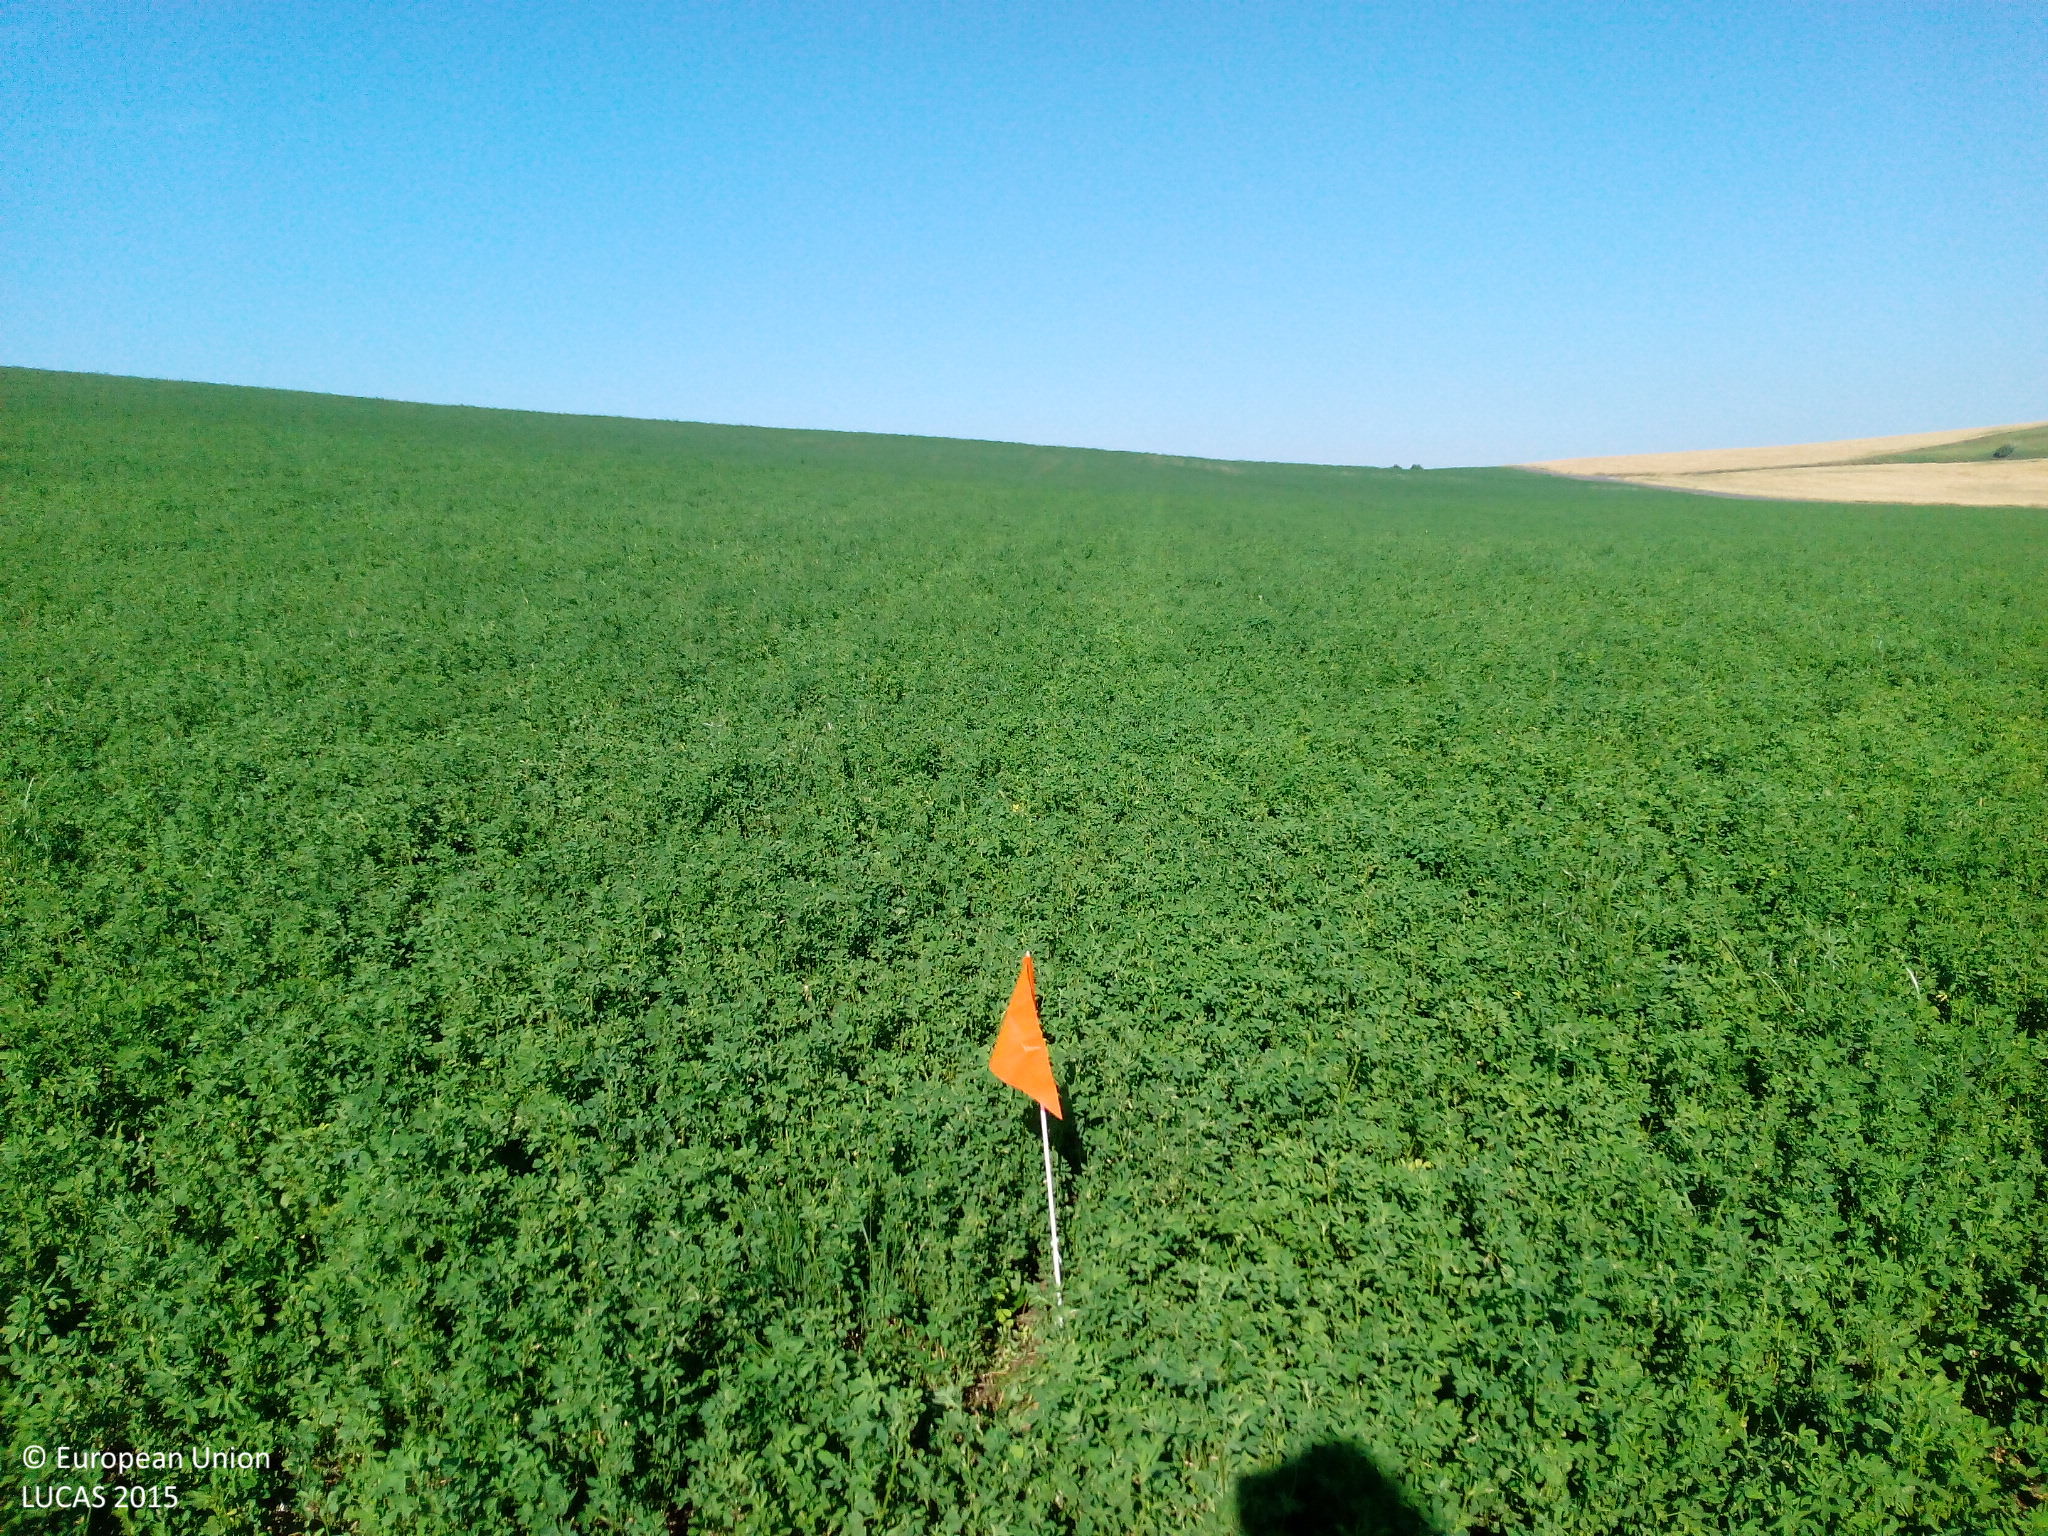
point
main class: Cropland
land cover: Lucerne
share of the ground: > 75 %
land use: Agriculture (excluding fallow land and kitchen gardens)
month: July
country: DE
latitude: 50.2904
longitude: 10.6314
